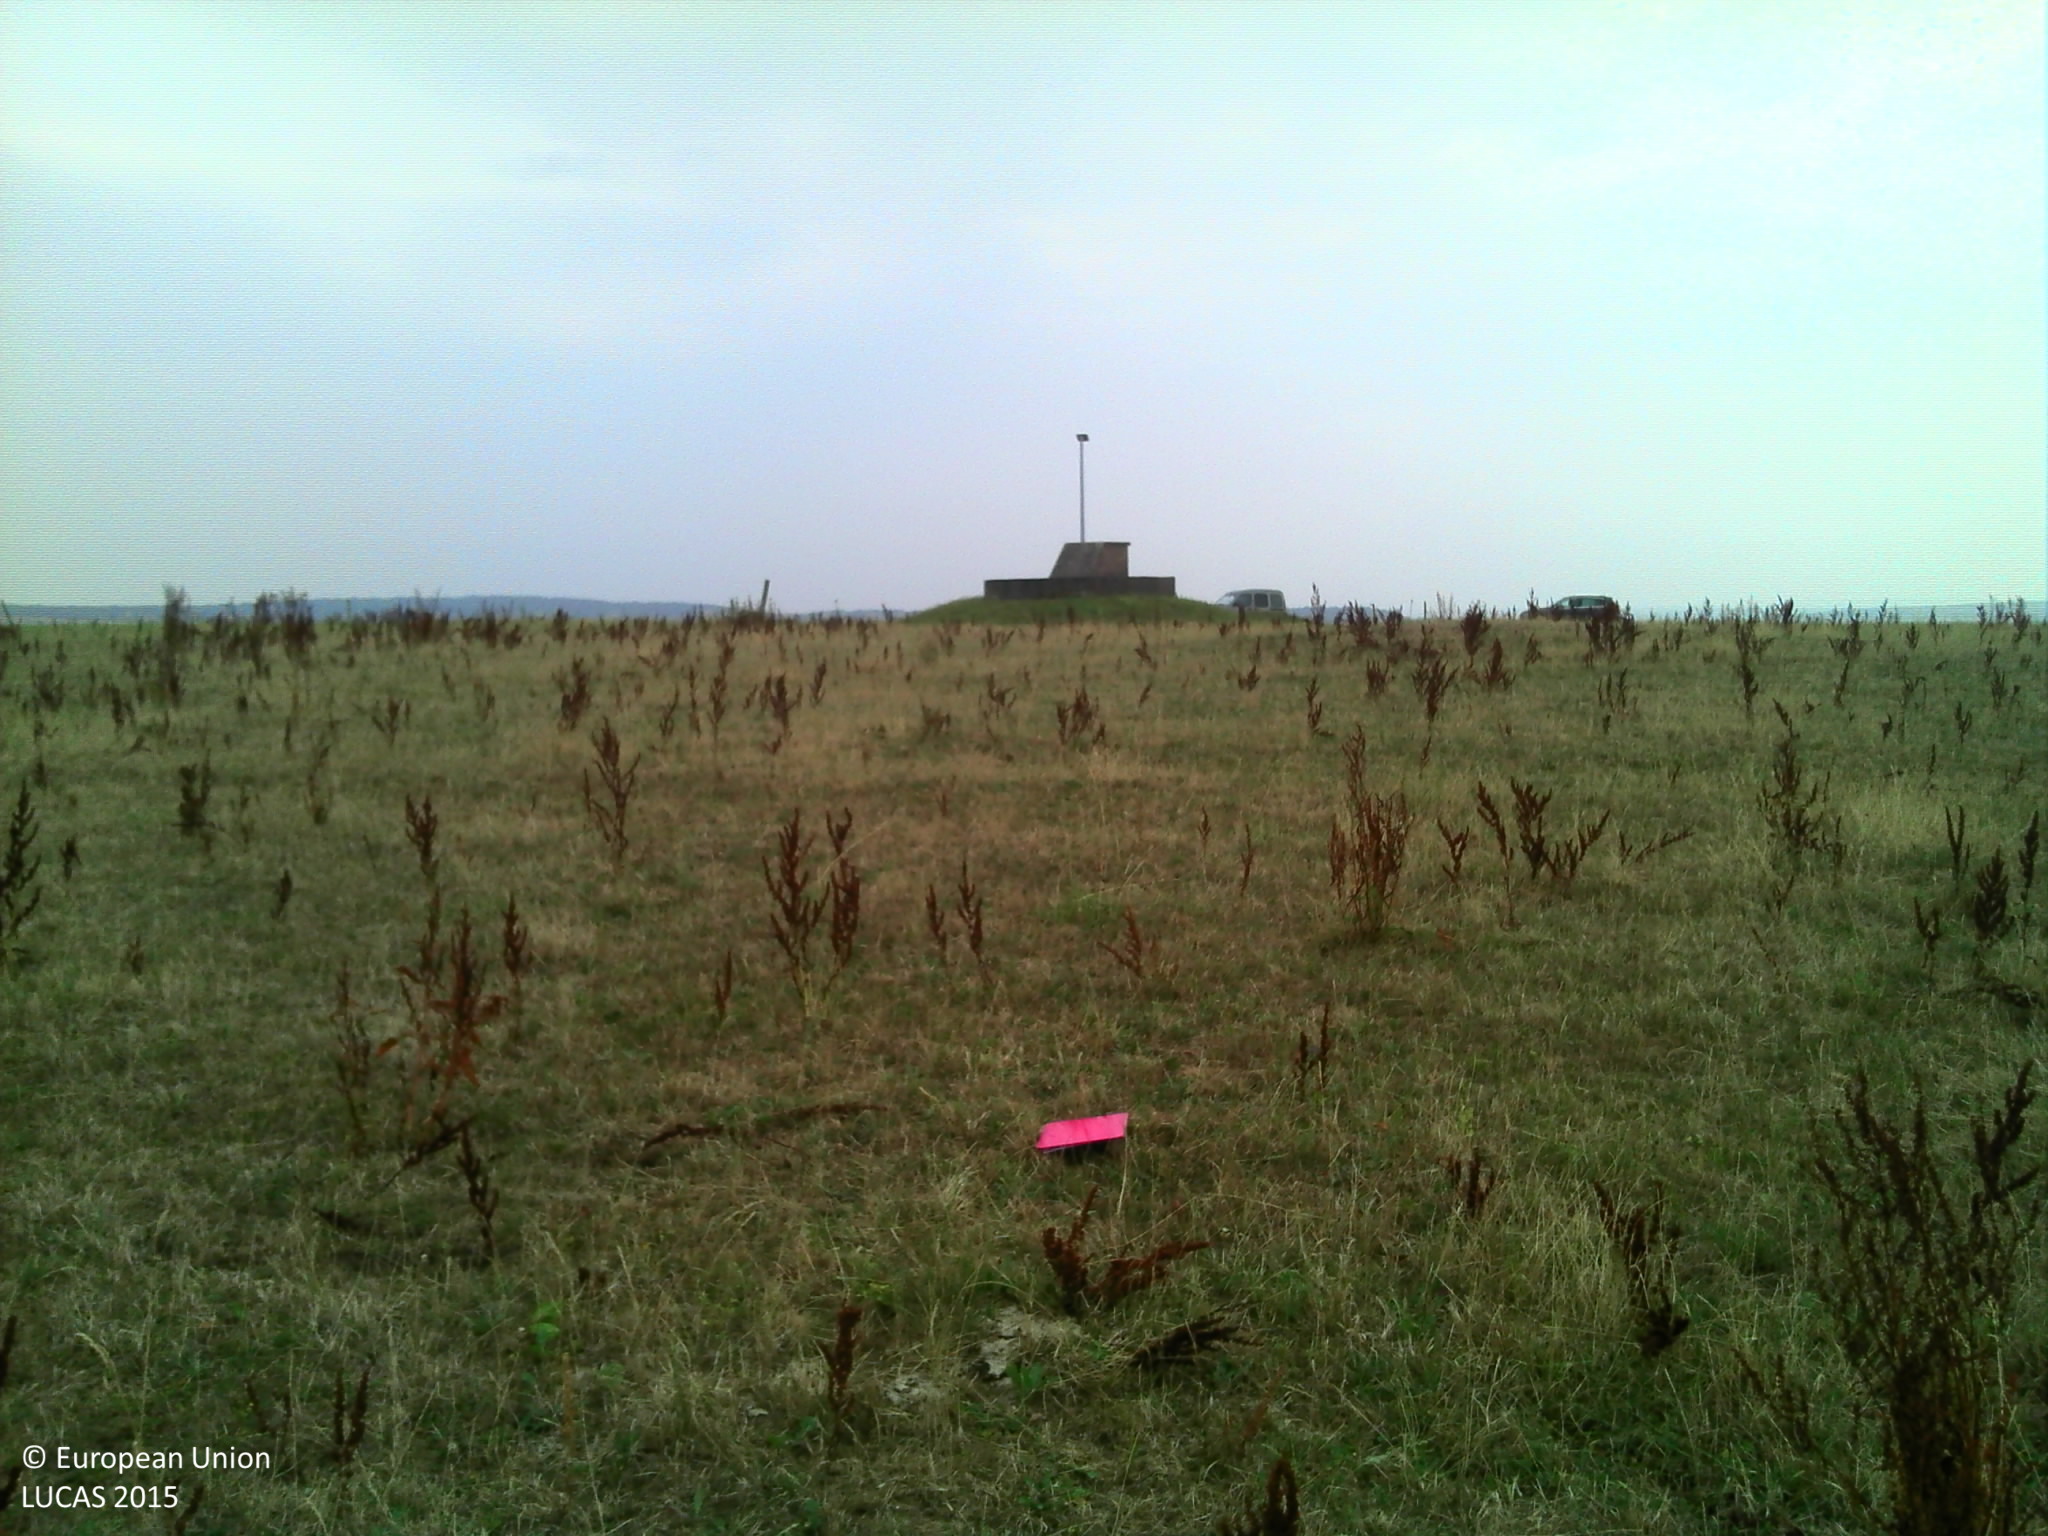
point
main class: Grassland
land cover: Grassland without tree/shrub cover
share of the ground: > 75 %
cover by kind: herbaceous plants 100 %
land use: Agriculture (excluding fallow land and kitchen gardens)
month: August
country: FR
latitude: 49.3478
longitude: 5.2767
